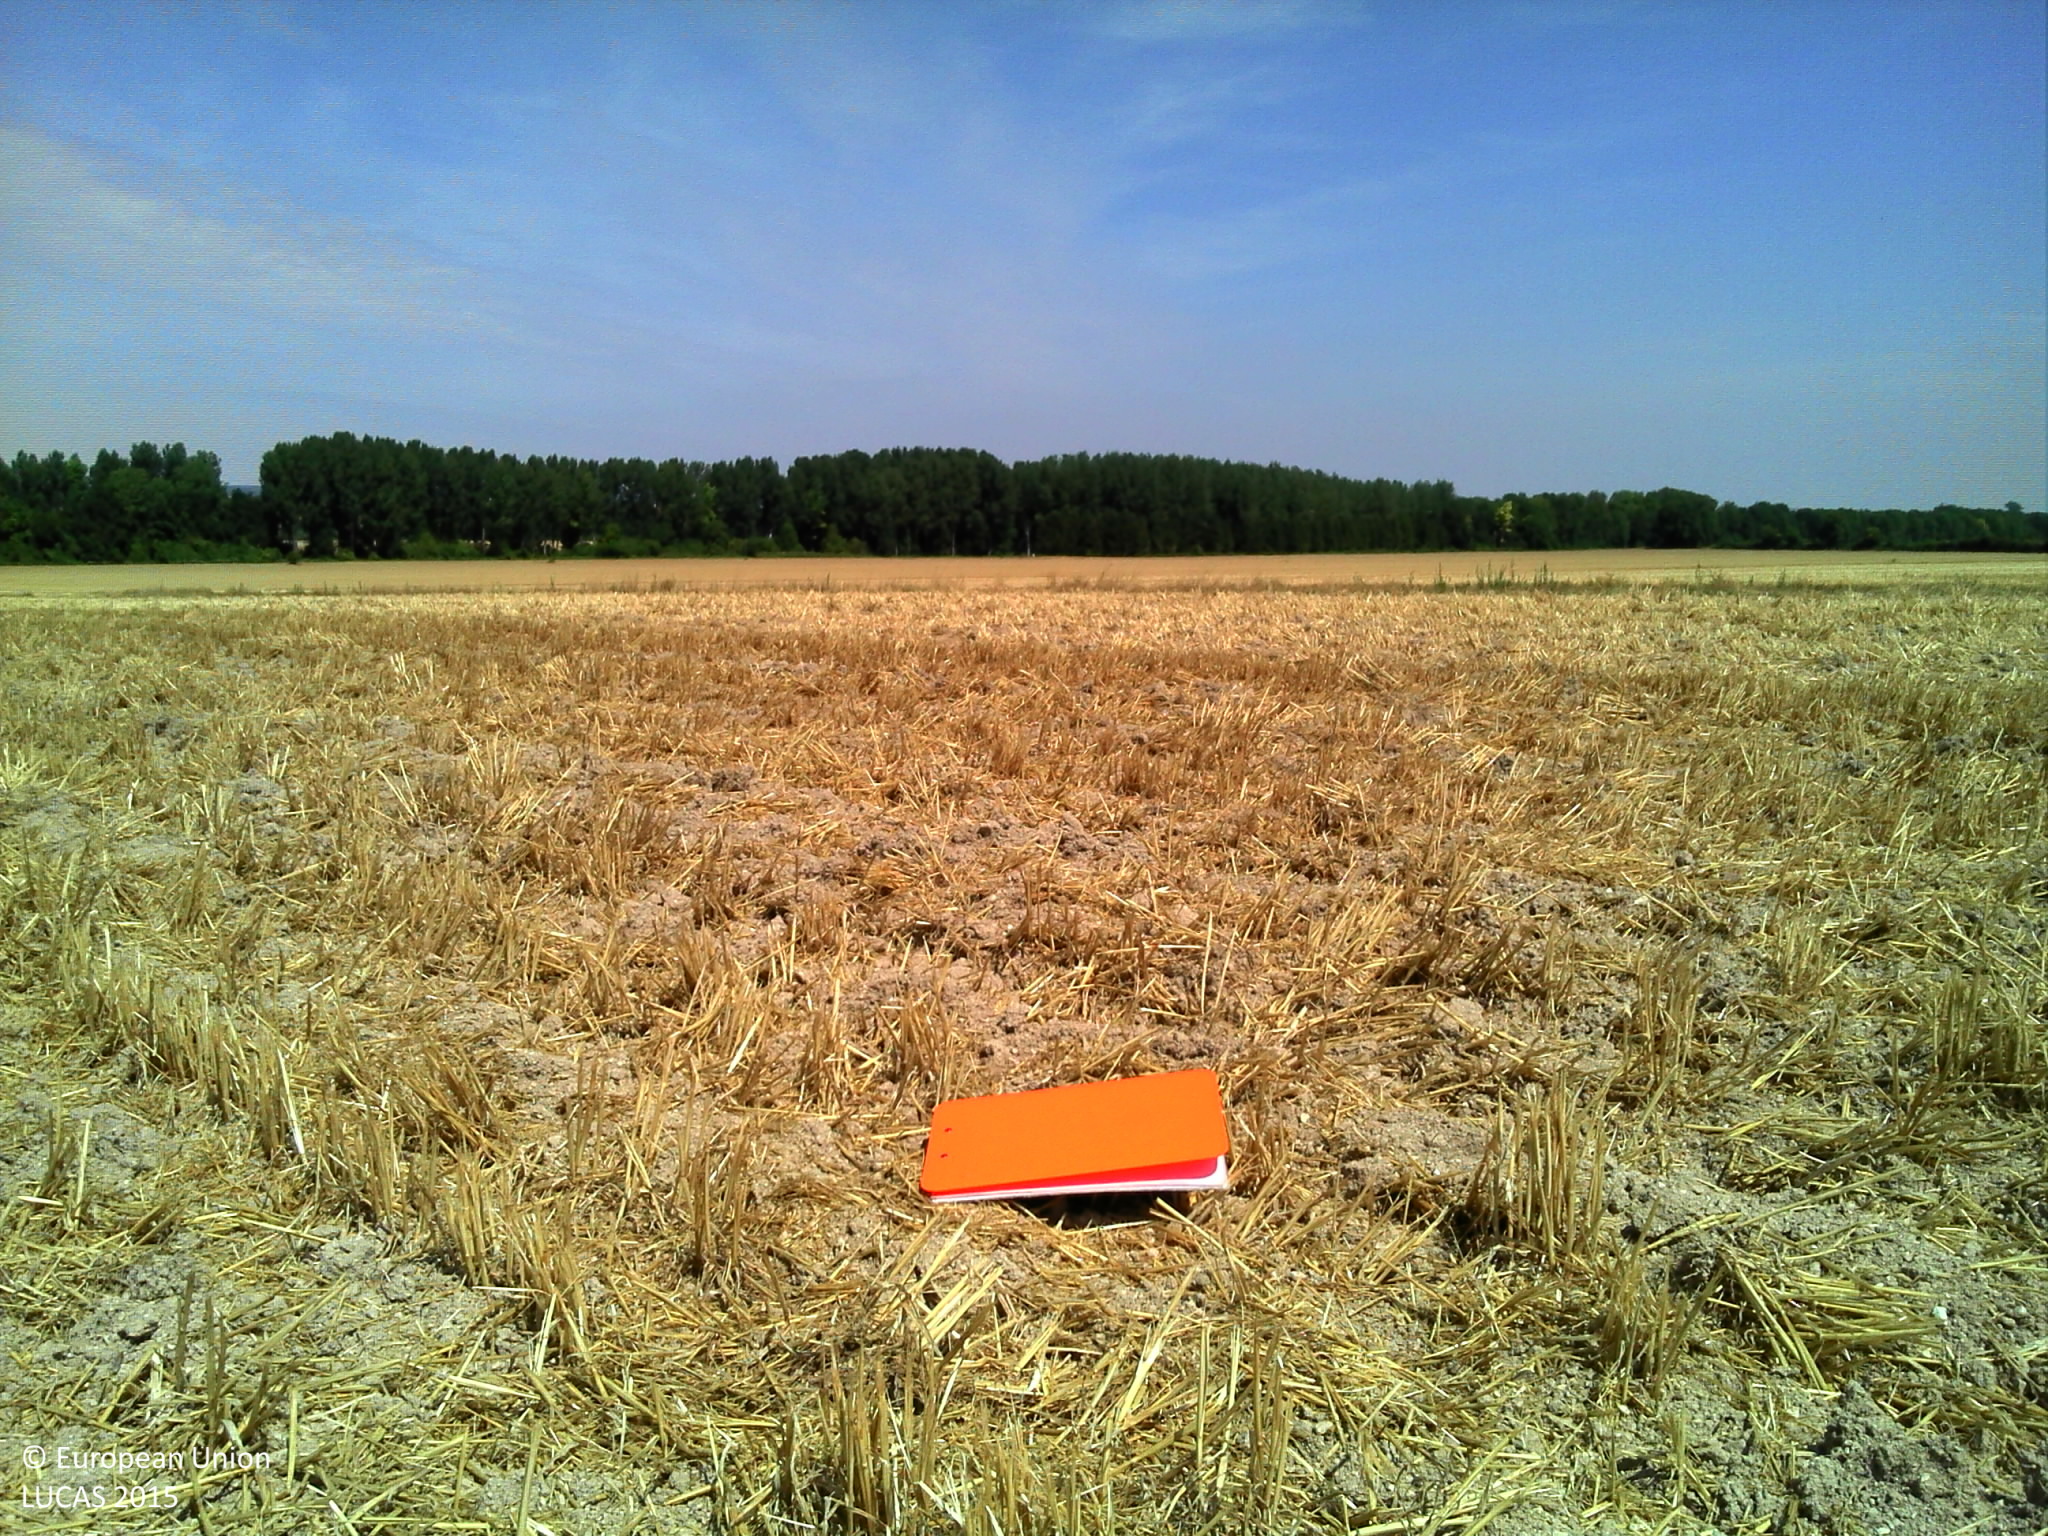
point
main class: Cropland
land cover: Common wheat
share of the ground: > 75 %
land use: Agriculture (excluding fallow land and kitchen gardens)
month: August
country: FR
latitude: 48.9859
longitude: 4.1059
